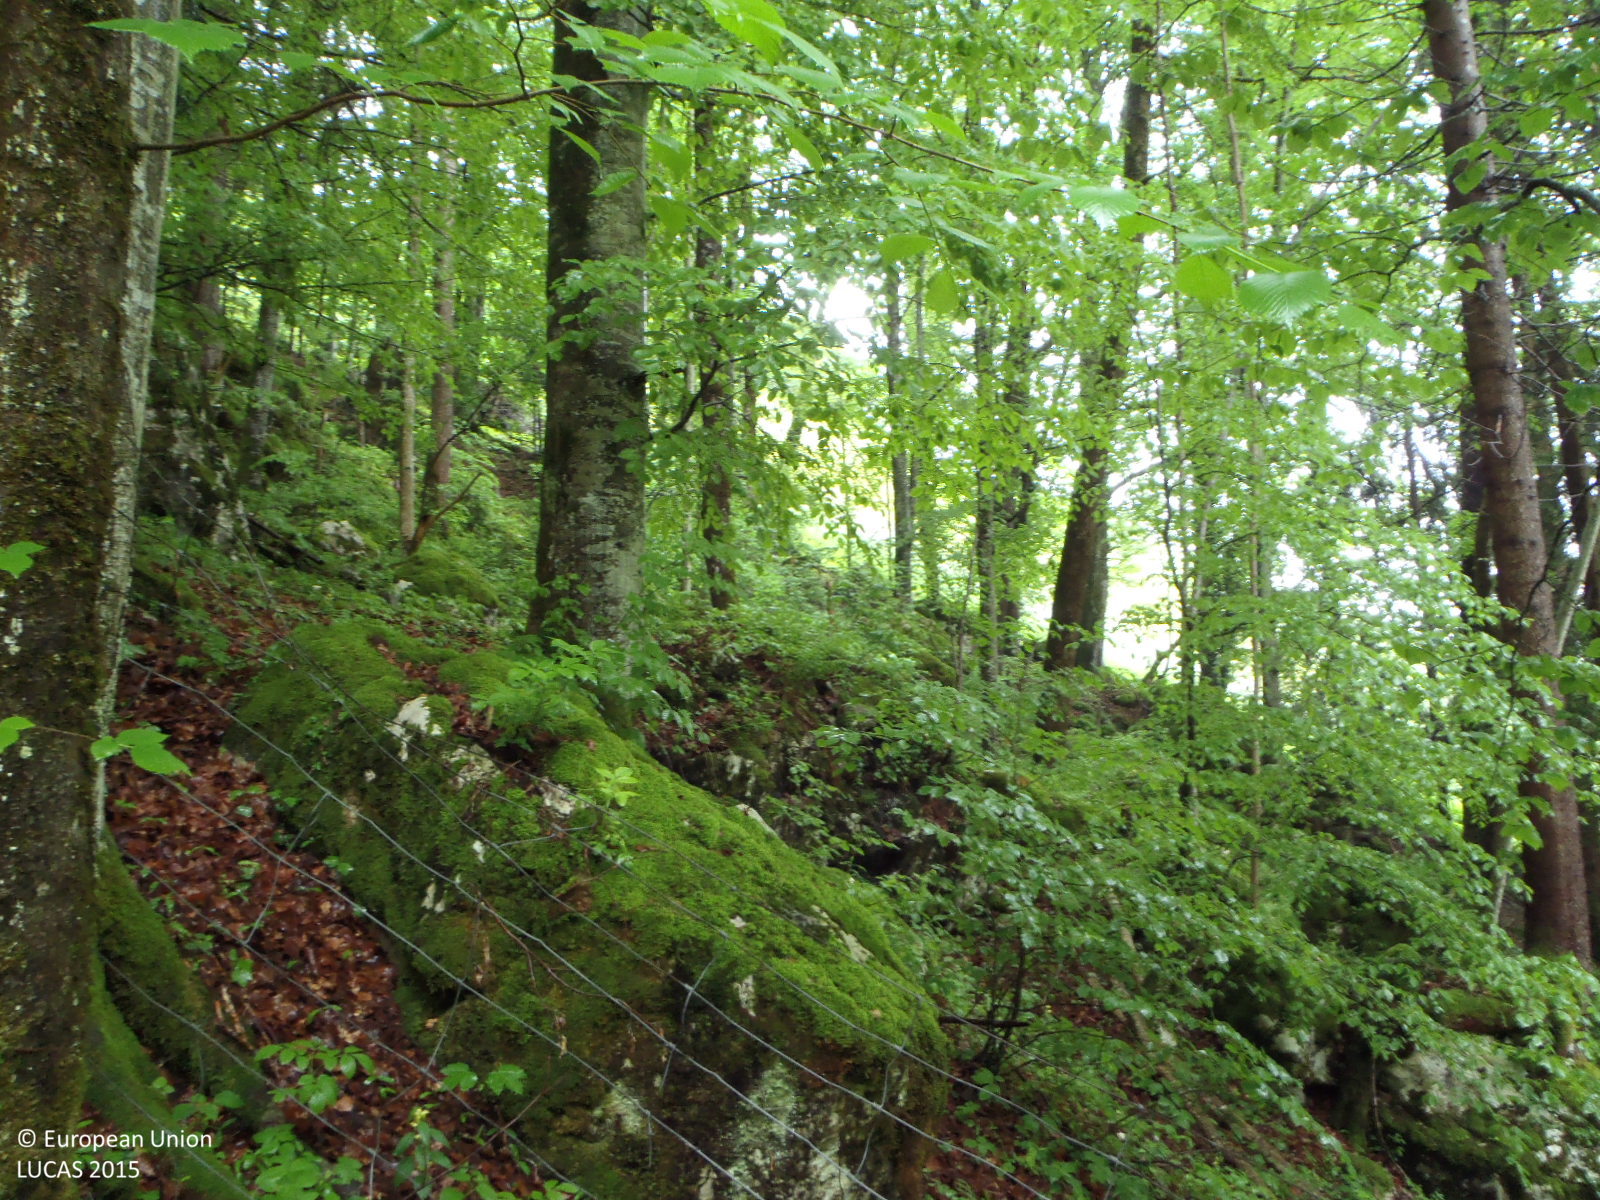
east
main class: Shrubland
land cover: Shrubland with sparse tree cover
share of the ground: > 75 %
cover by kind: herbaceous plants 55 %, shrubs 25 %, lichens and mosses 10 %, broadleaved forest trees 5 %, unconsolidated bare surface 5 %
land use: Forestry
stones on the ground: < 10 %
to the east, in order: Shrubland with sparse tree cover; Broadleaved woodland; Fences; Broadleaved woodland; Fences; Broadleaved woodland; Grassland without tree/shrub cover; Other fruit trees and berries; Artificial constructions in urban areas; Grassland without tree/shrub cover
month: May
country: AT
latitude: 47.6503
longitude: 12.7010
